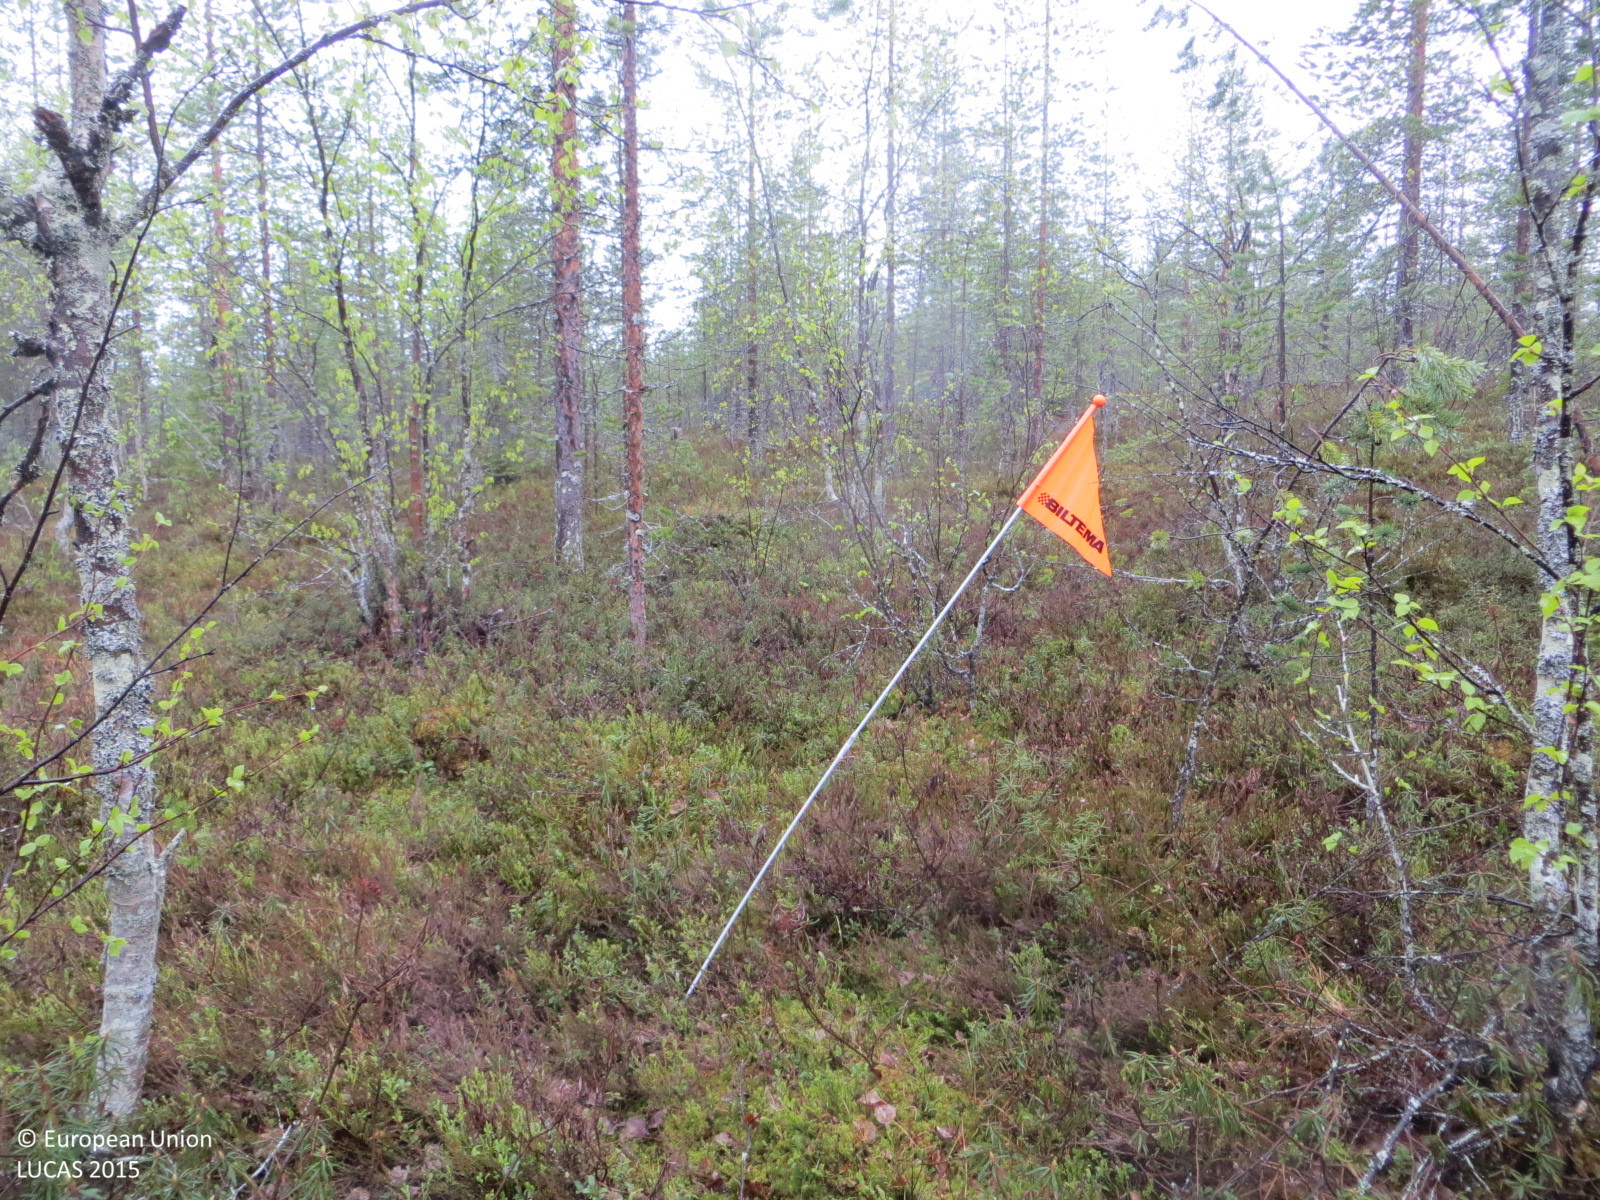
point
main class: Woodland
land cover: Other mixed woodland
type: boreal forest
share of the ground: > 75 %
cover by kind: coniferous forest trees 50 %, broadleaved forest trees 30 %, shrubs 20 %
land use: Forestry
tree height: > 5 m
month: June
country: FI
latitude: 66.8779
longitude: 25.4147
